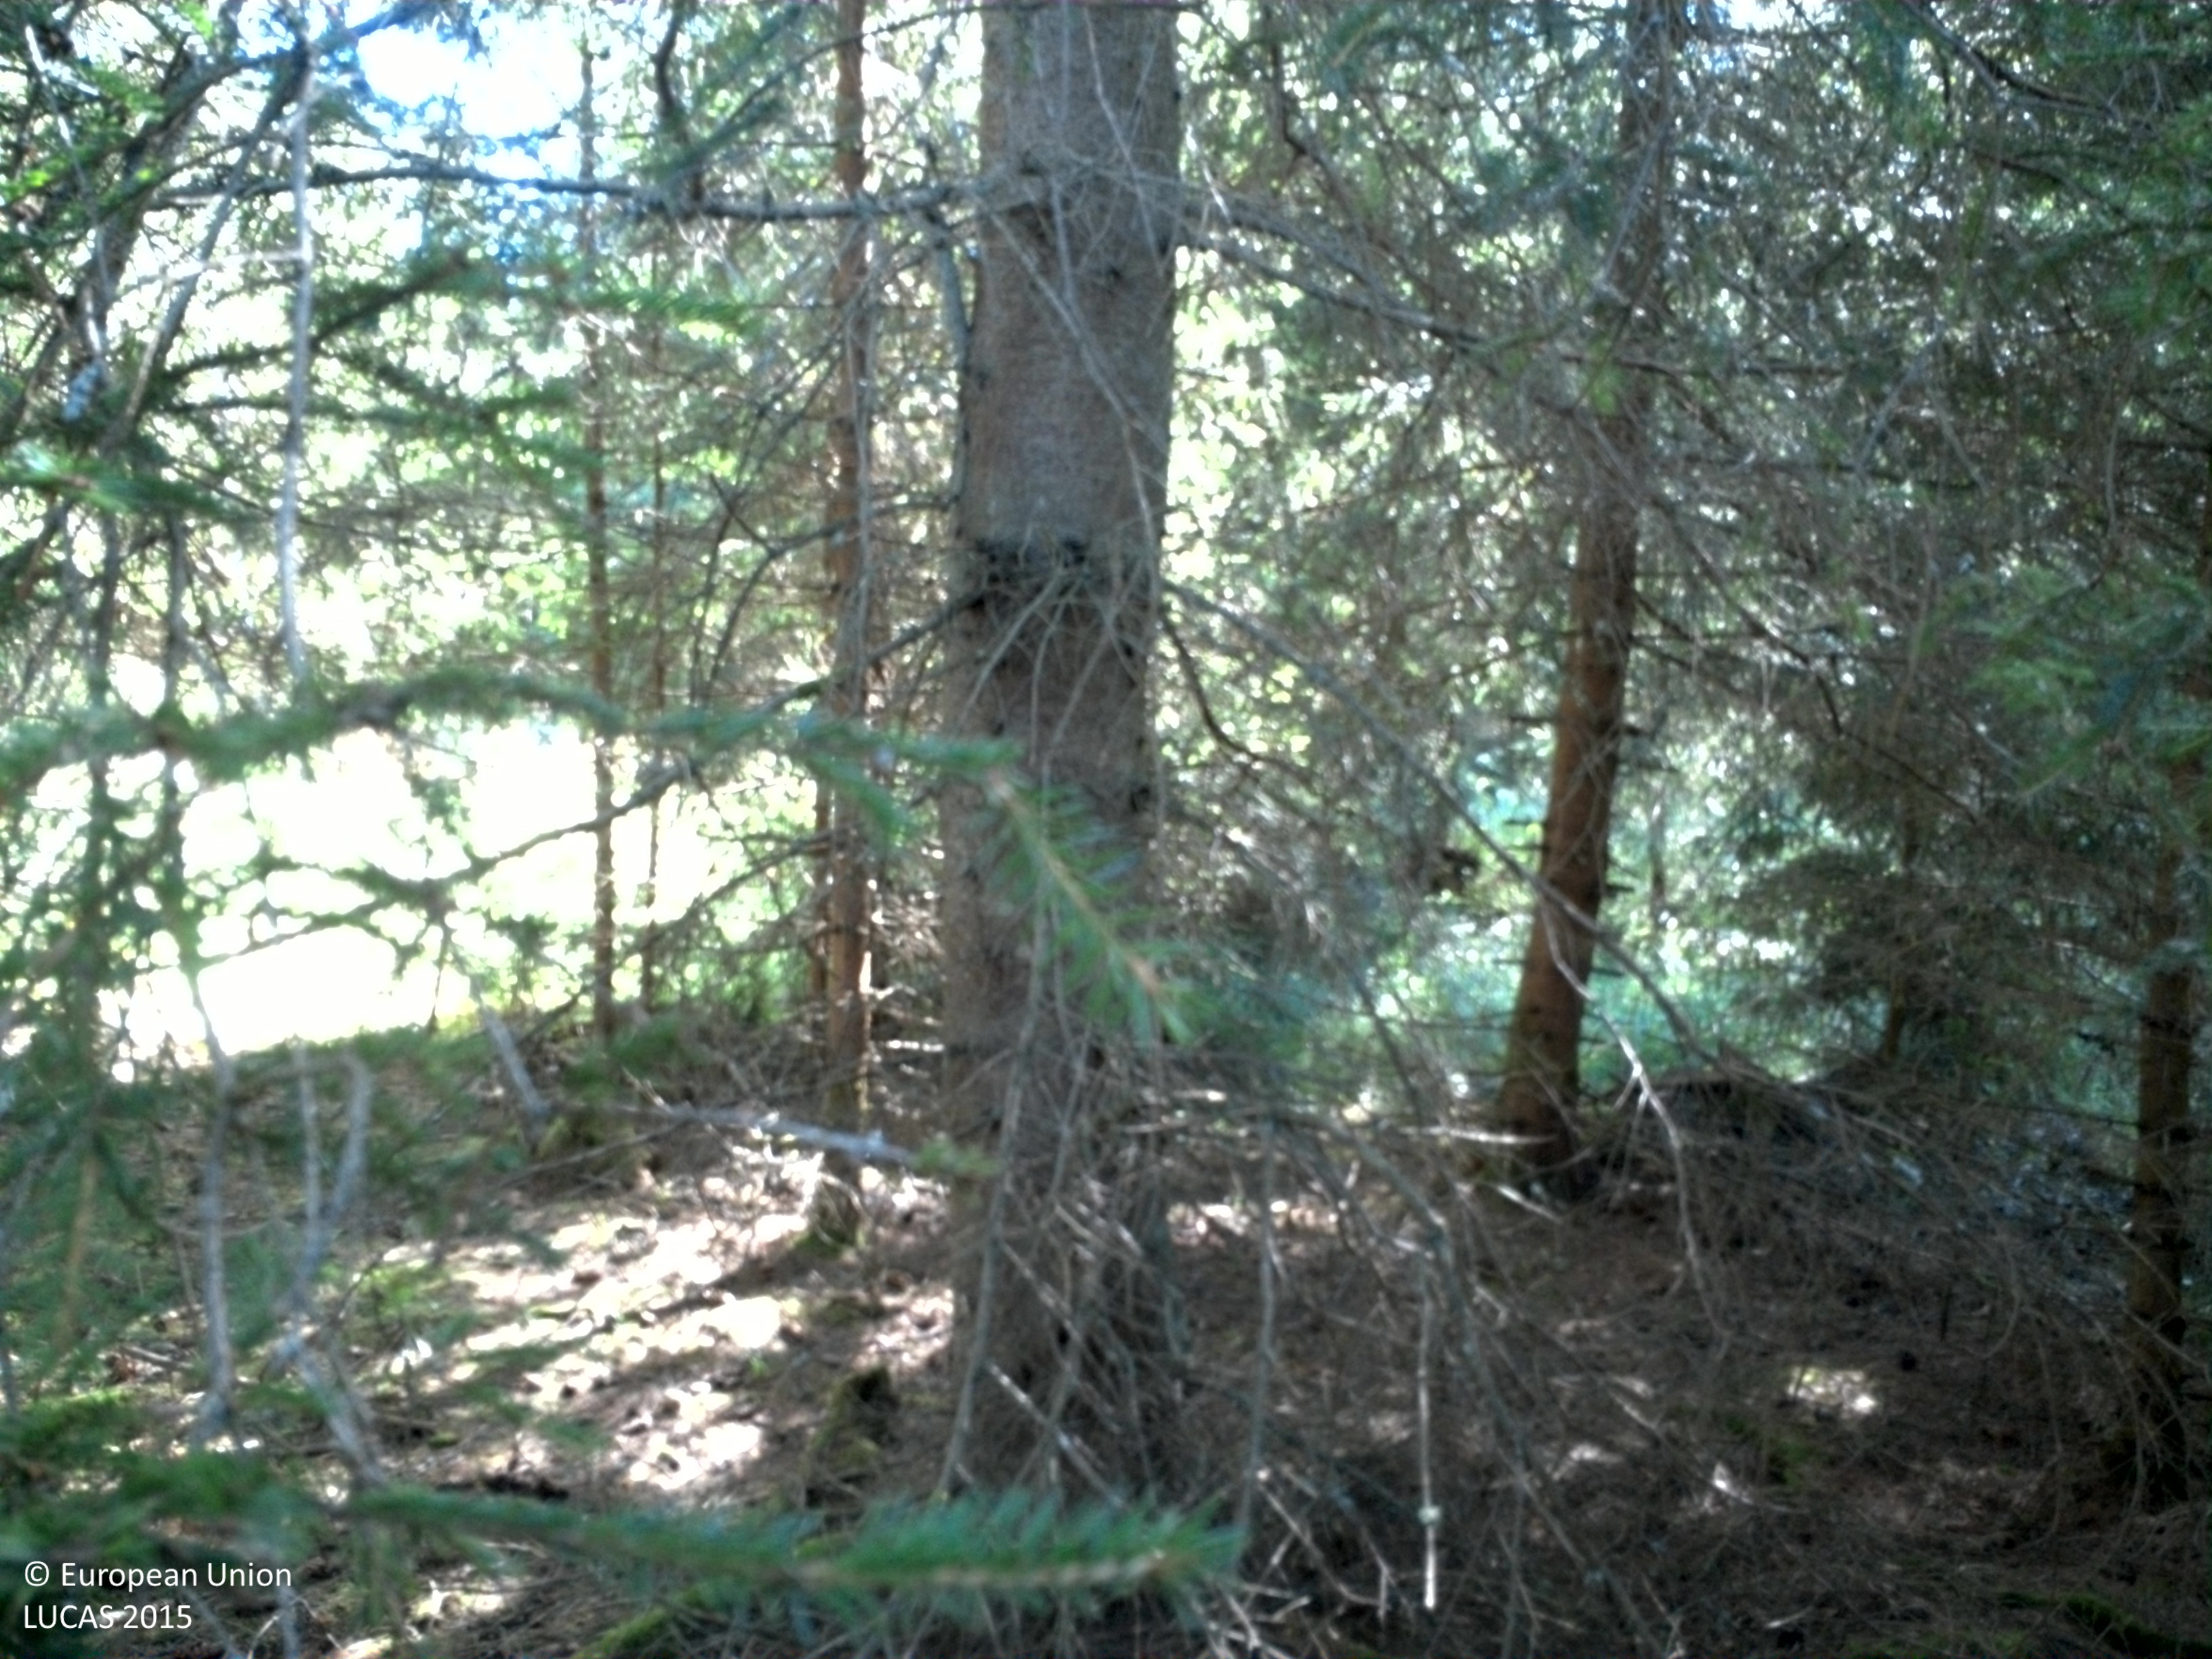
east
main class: Woodland
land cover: Spruce dominated coniferous woodland
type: boreal forest
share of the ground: 50 - 75 %
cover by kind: coniferous forest trees 70 %, lichens and mosses 25 %, herbaceous plants 5 %
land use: Forestry
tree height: > 5 m
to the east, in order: Spruce dominated coniferous woodland; Spruce dominated mixed woodland; Spruce dominated coniferous woodland; Ditches and canals; Spruce dominated coniferous woodland; Ditches and canals; Spruce dominated coniferous woodland; Ditches and canals; Spruce dominated coniferous woodland
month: August
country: SE
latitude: 58.2147
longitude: 13.3137
